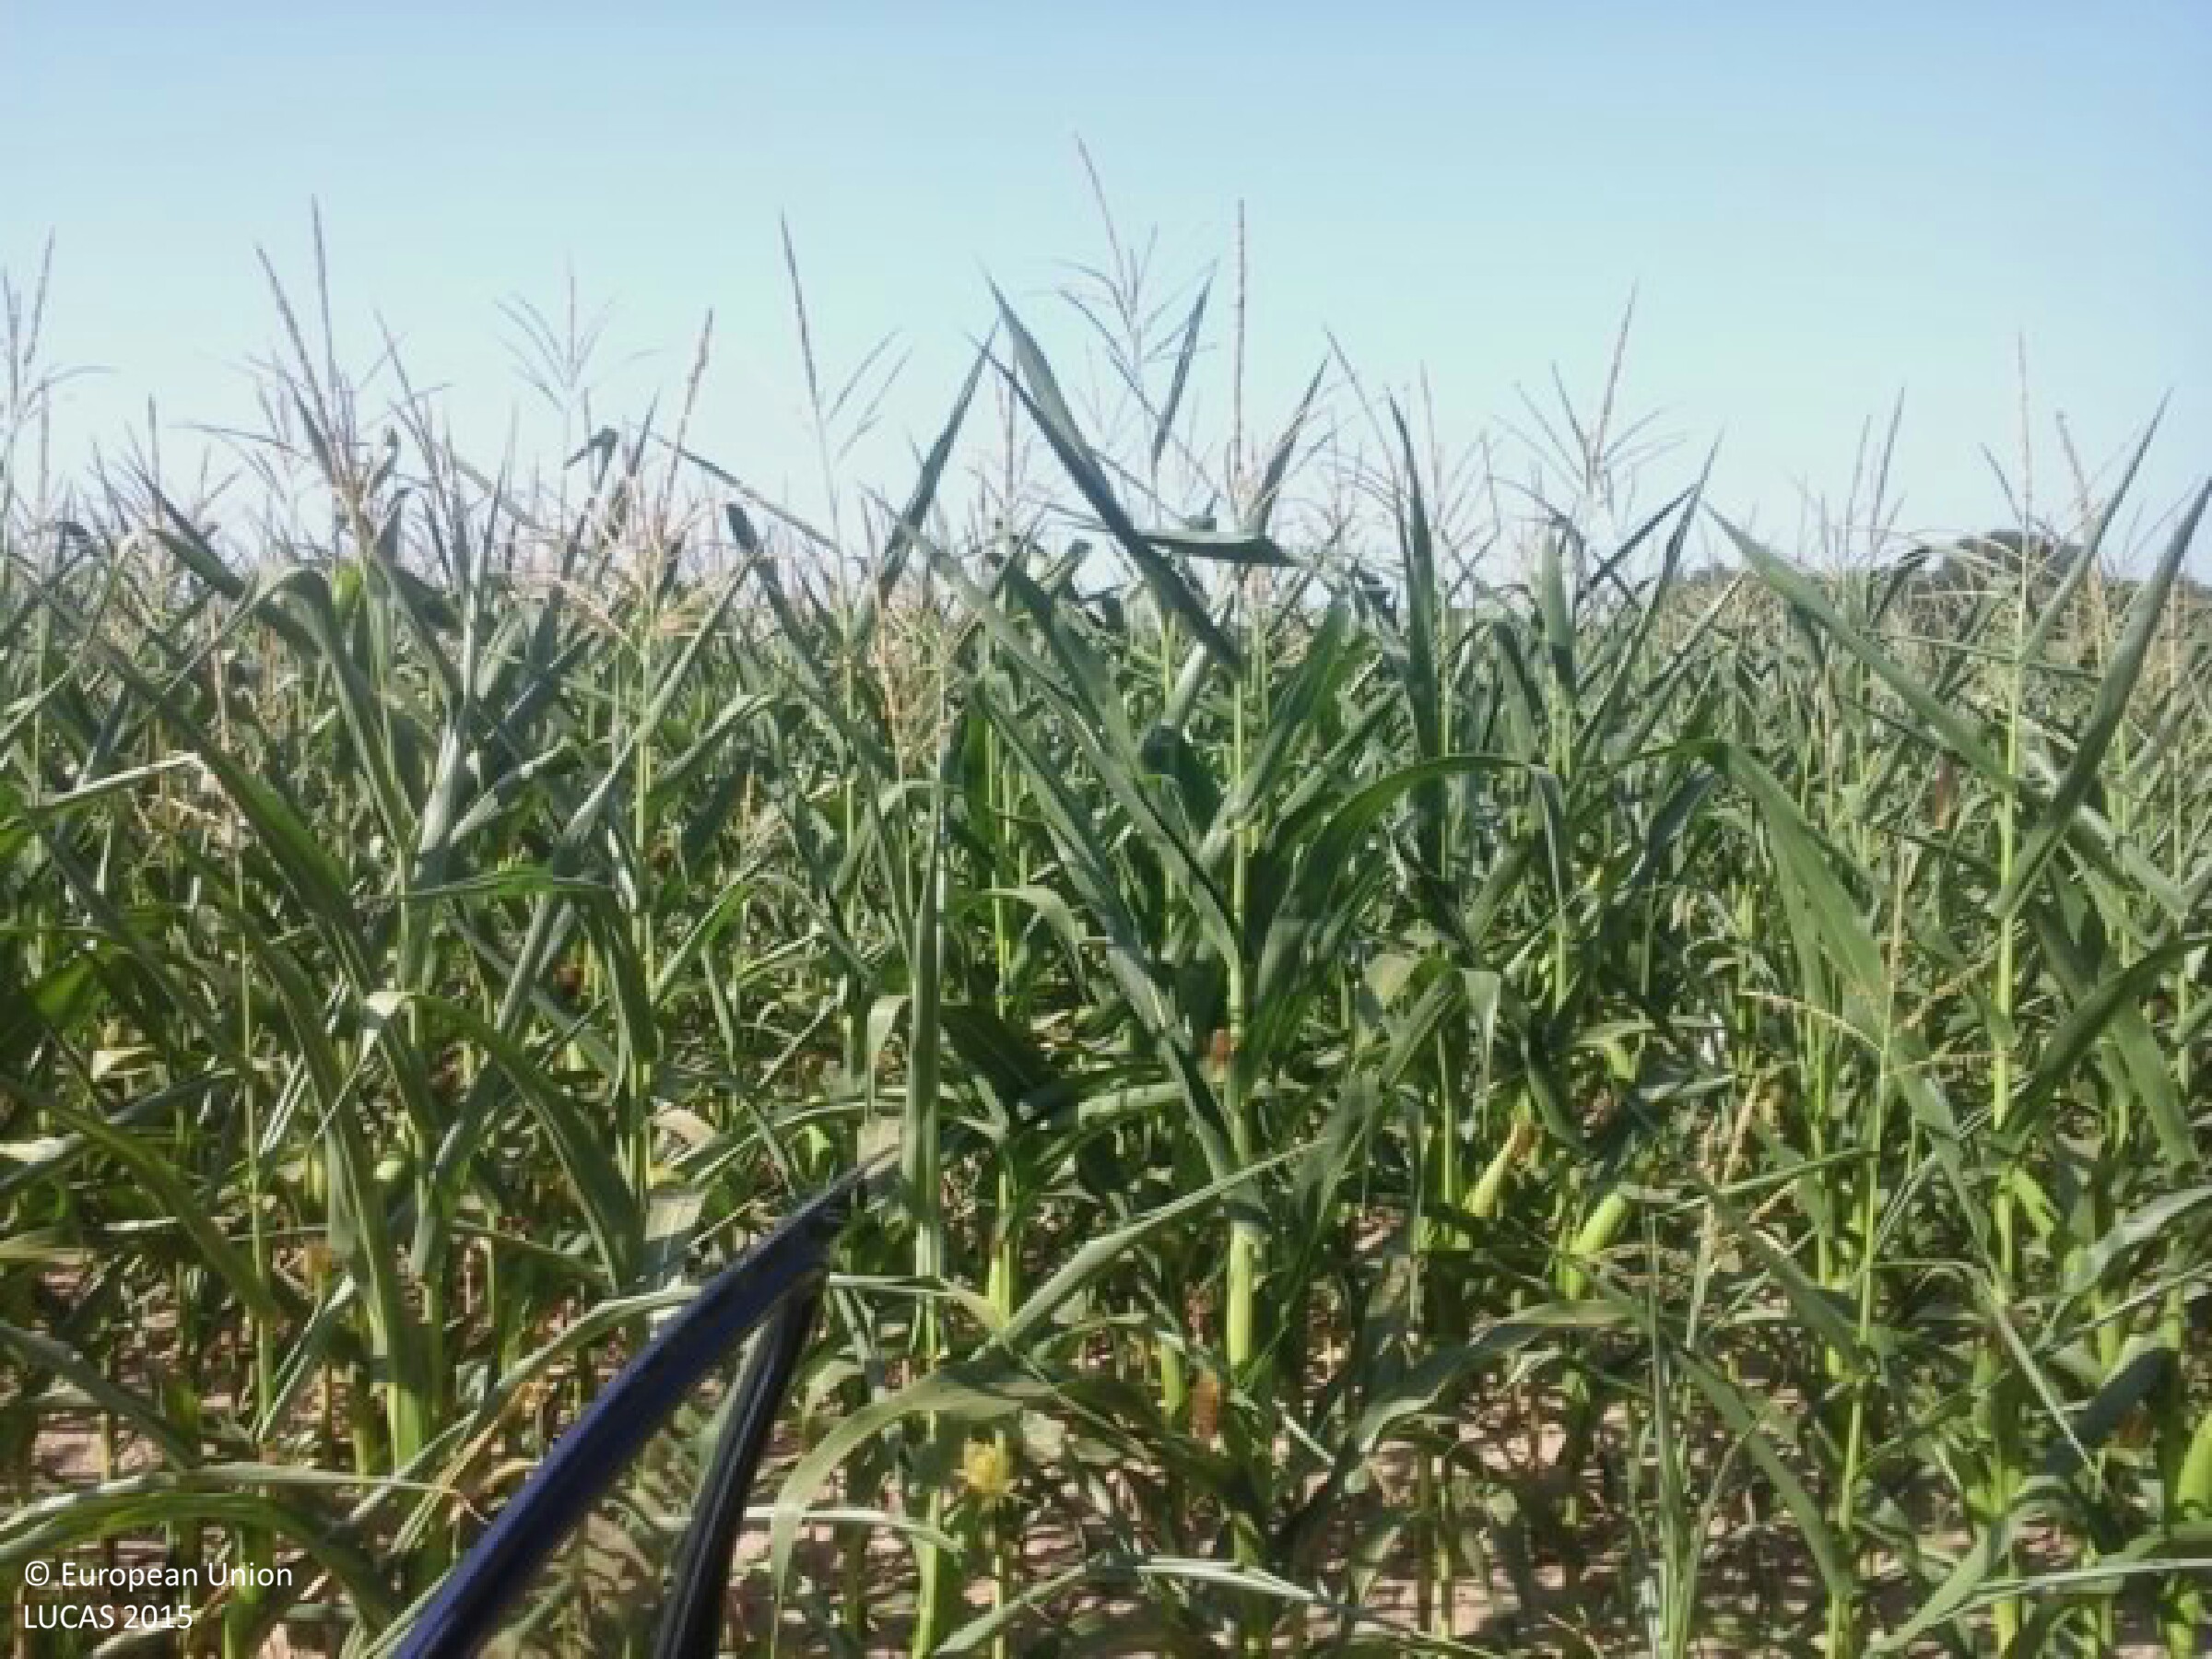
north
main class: Cropland
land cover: Maize
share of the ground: > 75 %
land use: Agriculture (excluding fallow land and kitchen gardens)
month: July
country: HU
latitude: 46.2385
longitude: 17.1481
